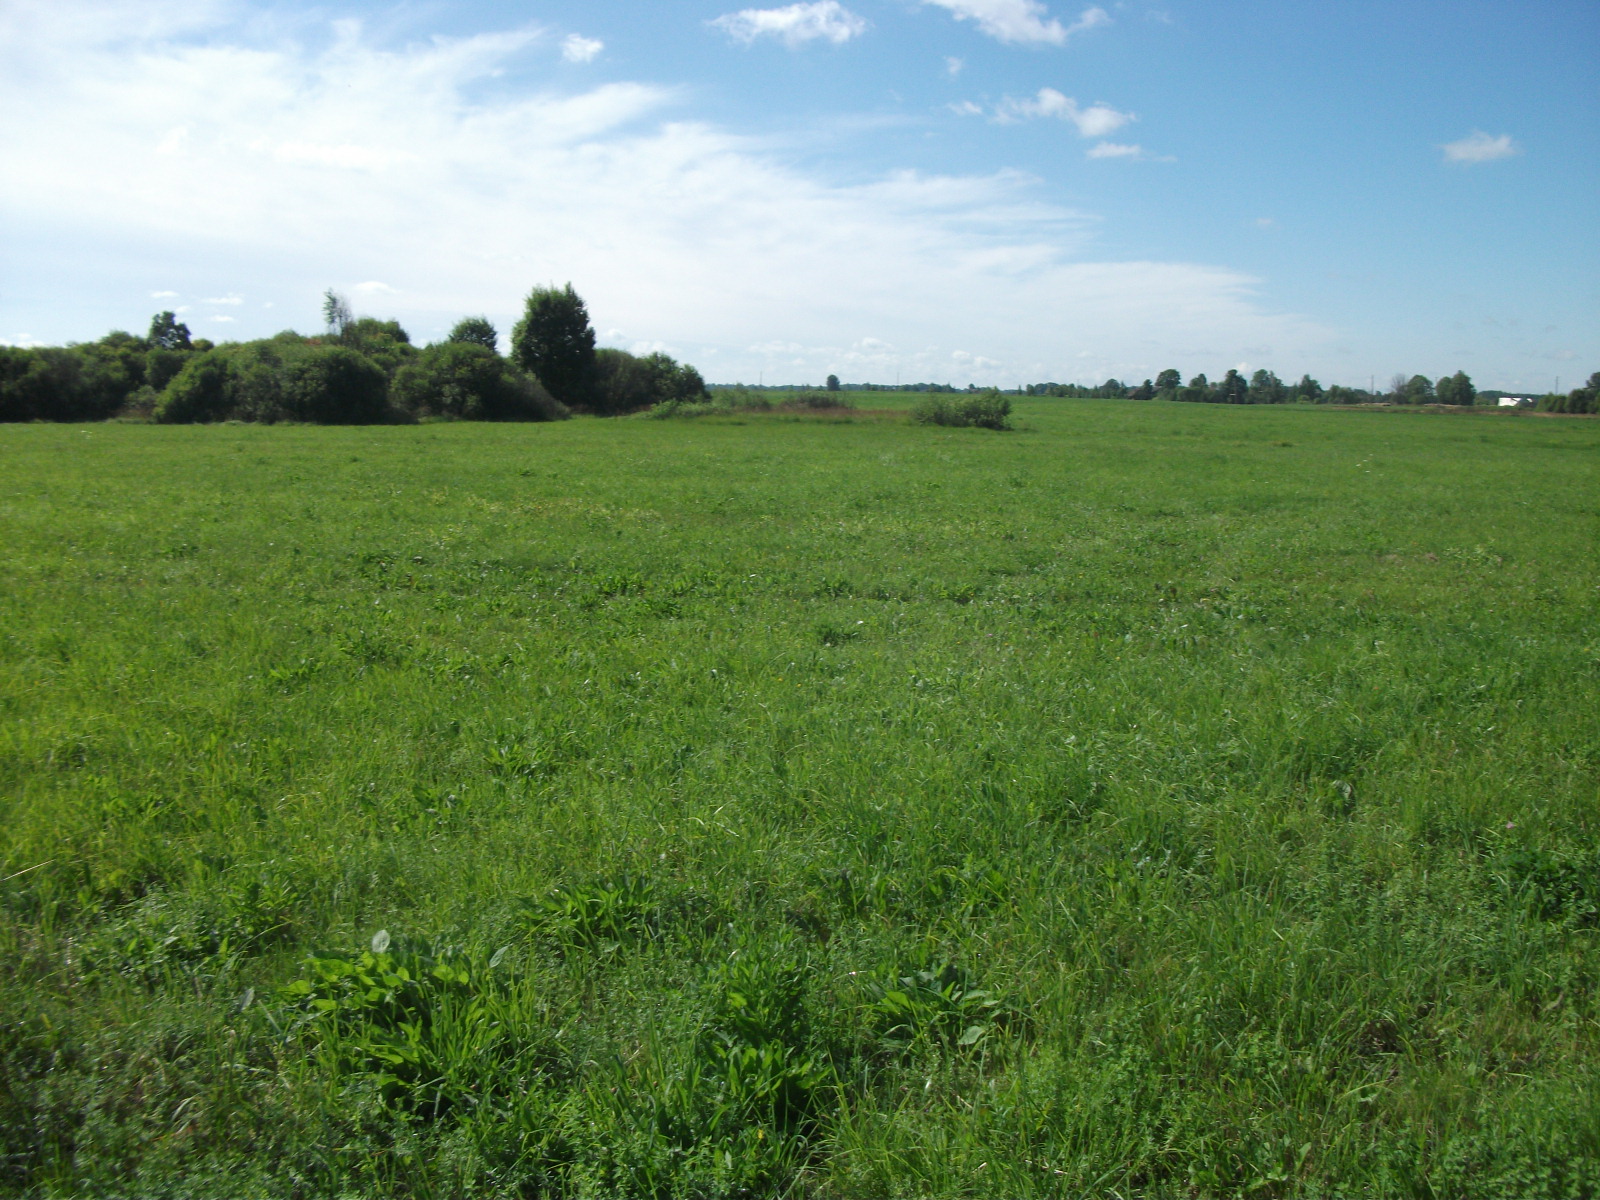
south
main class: Grassland
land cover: Grassland without tree/shrub cover
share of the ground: > 75 %
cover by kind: herbaceous plants 100 %
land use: Agriculture (excluding fallow land and kitchen gardens)
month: August
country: LV
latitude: 56.4443
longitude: 26.4158
